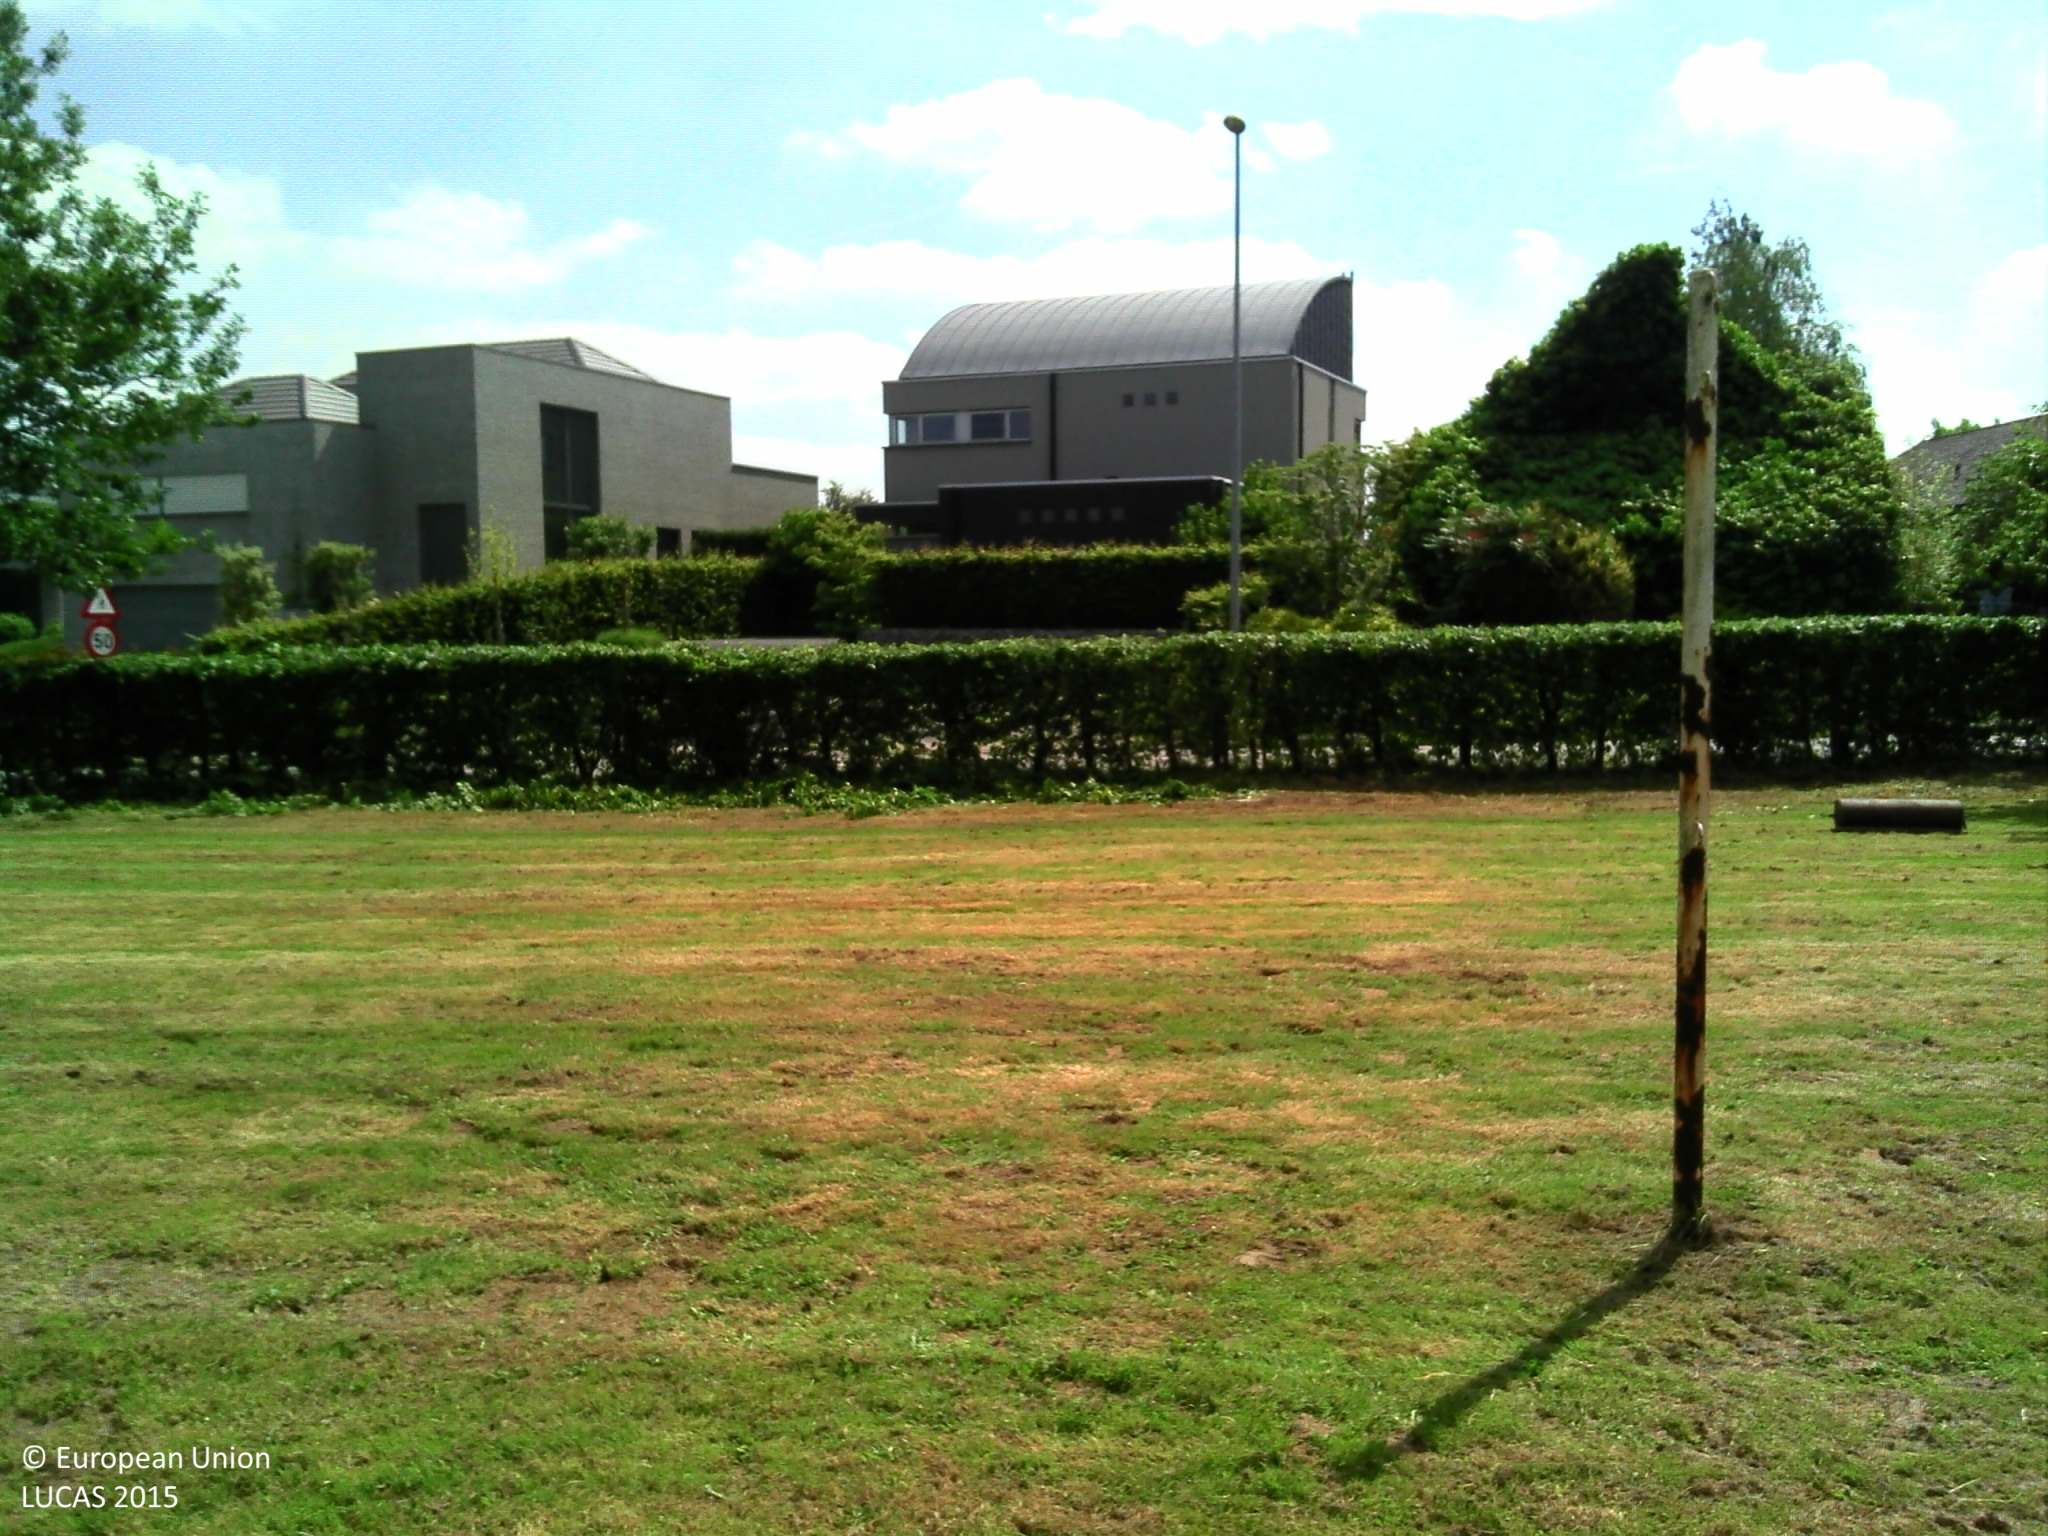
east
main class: Grassland
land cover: Grassland without tree/shrub cover
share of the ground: > 75 %
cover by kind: herbaceous plants 100 %
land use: Sport
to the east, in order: Grassland without tree/shrub cover; Managed hedges; Artificial constructions in urban areas; Grassland without tree/shrub cover; Fences; Maize
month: June
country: BE
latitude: 50.9012
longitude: 3.8365
